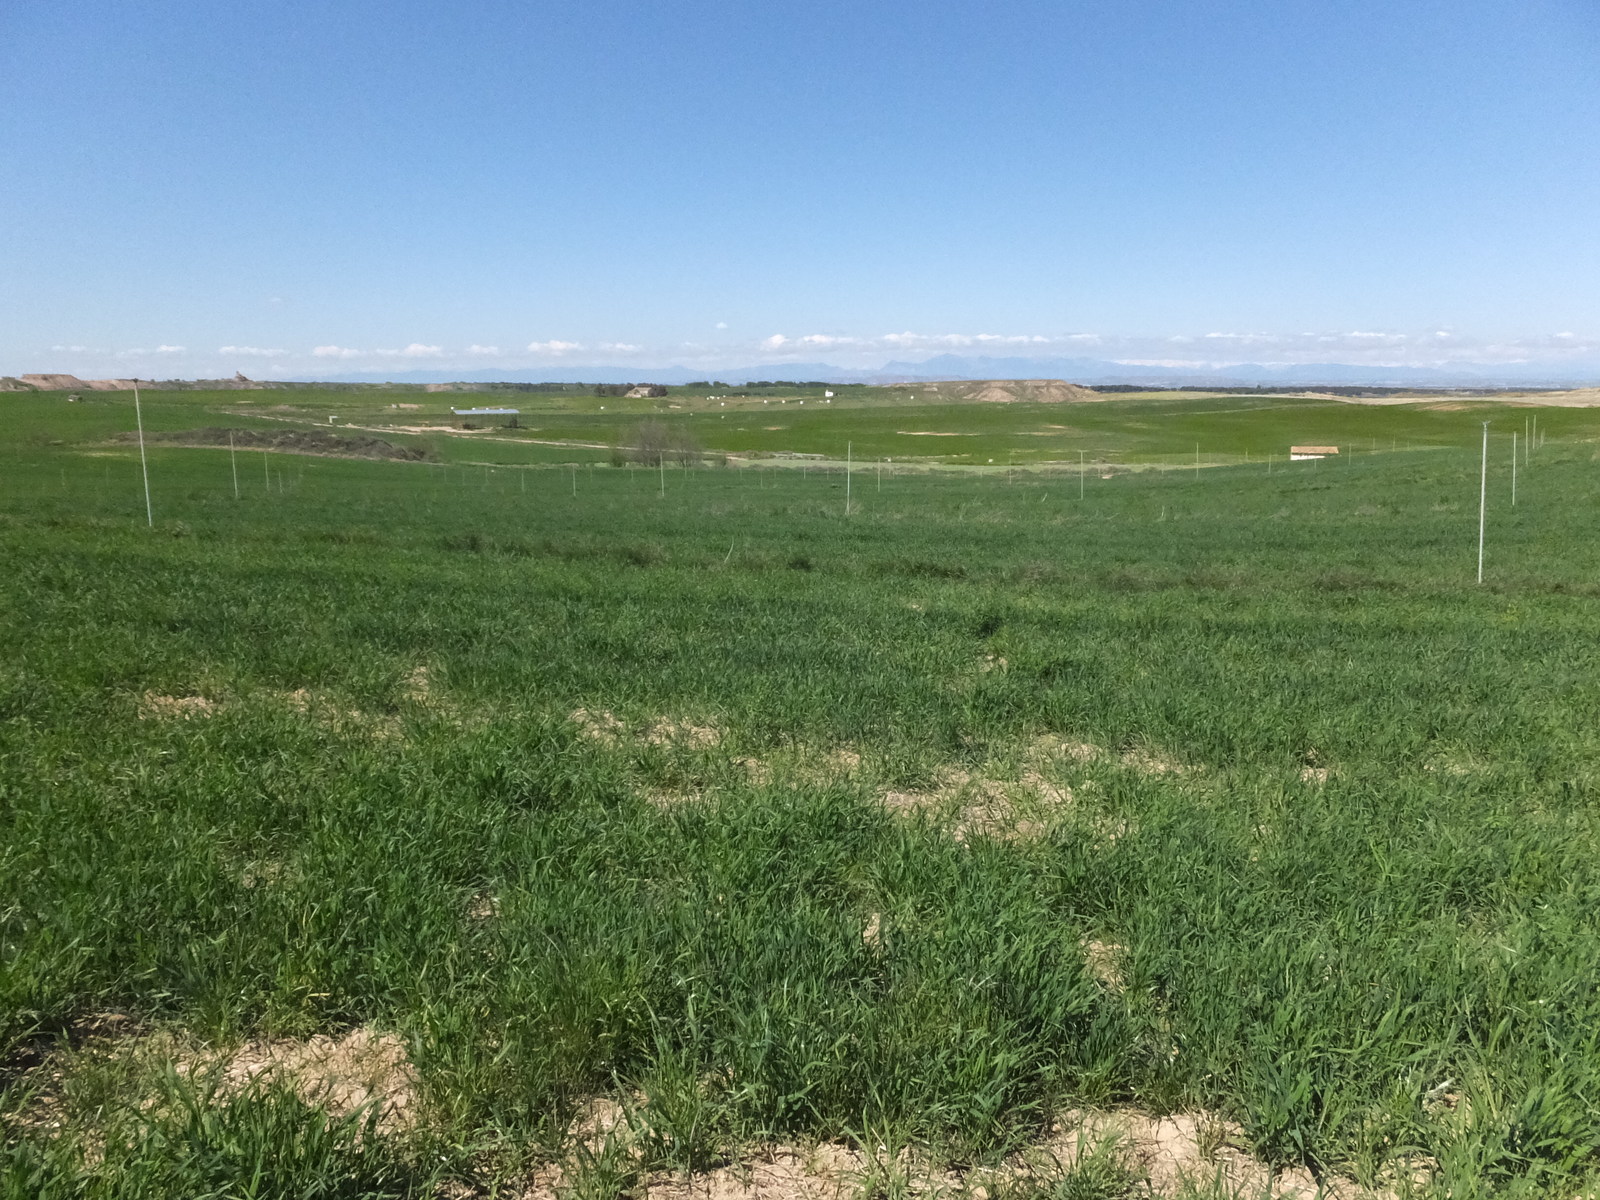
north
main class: Cropland
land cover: Durum wheat
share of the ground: > 75 %
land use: Agriculture (excluding fallow land and kitchen gardens)
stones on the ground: < 10 %
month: April
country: ES
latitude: 41.7122
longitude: -0.2700
